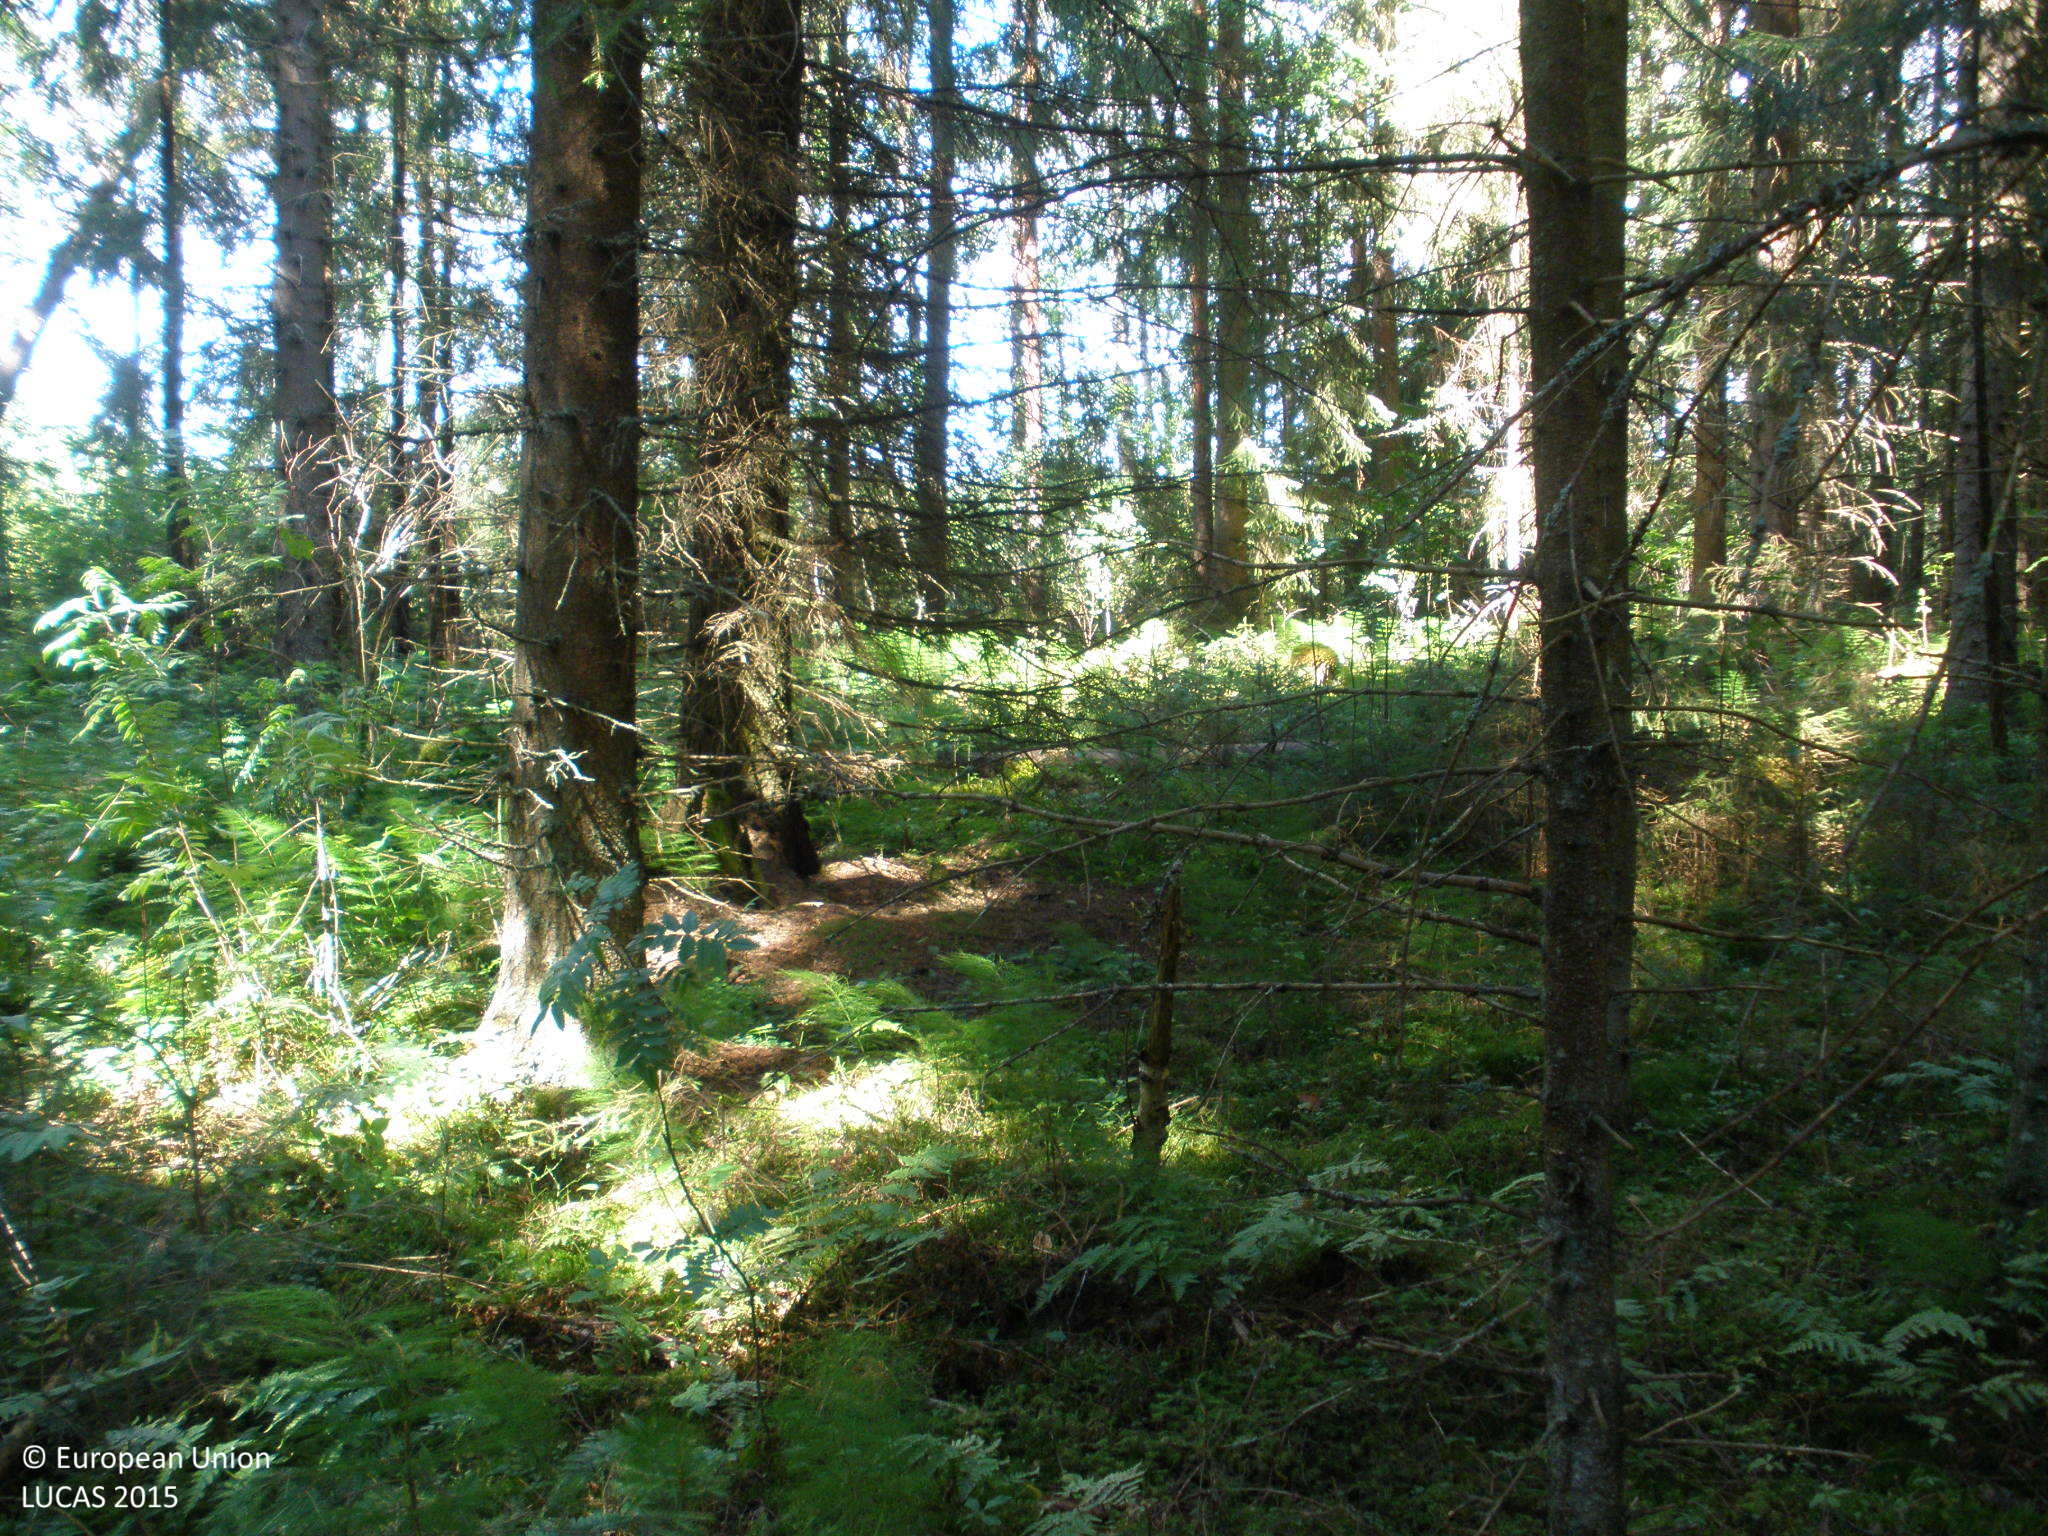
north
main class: Woodland
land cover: Spruce dominated coniferous woodland
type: boreal forest
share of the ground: > 75 %
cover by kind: coniferous forest trees 90 %, herbaceous plants 5 %, lichens and mosses 5 %
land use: Forestry
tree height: > 5 m
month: August
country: FI
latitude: 60.8177
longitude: 24.3497
